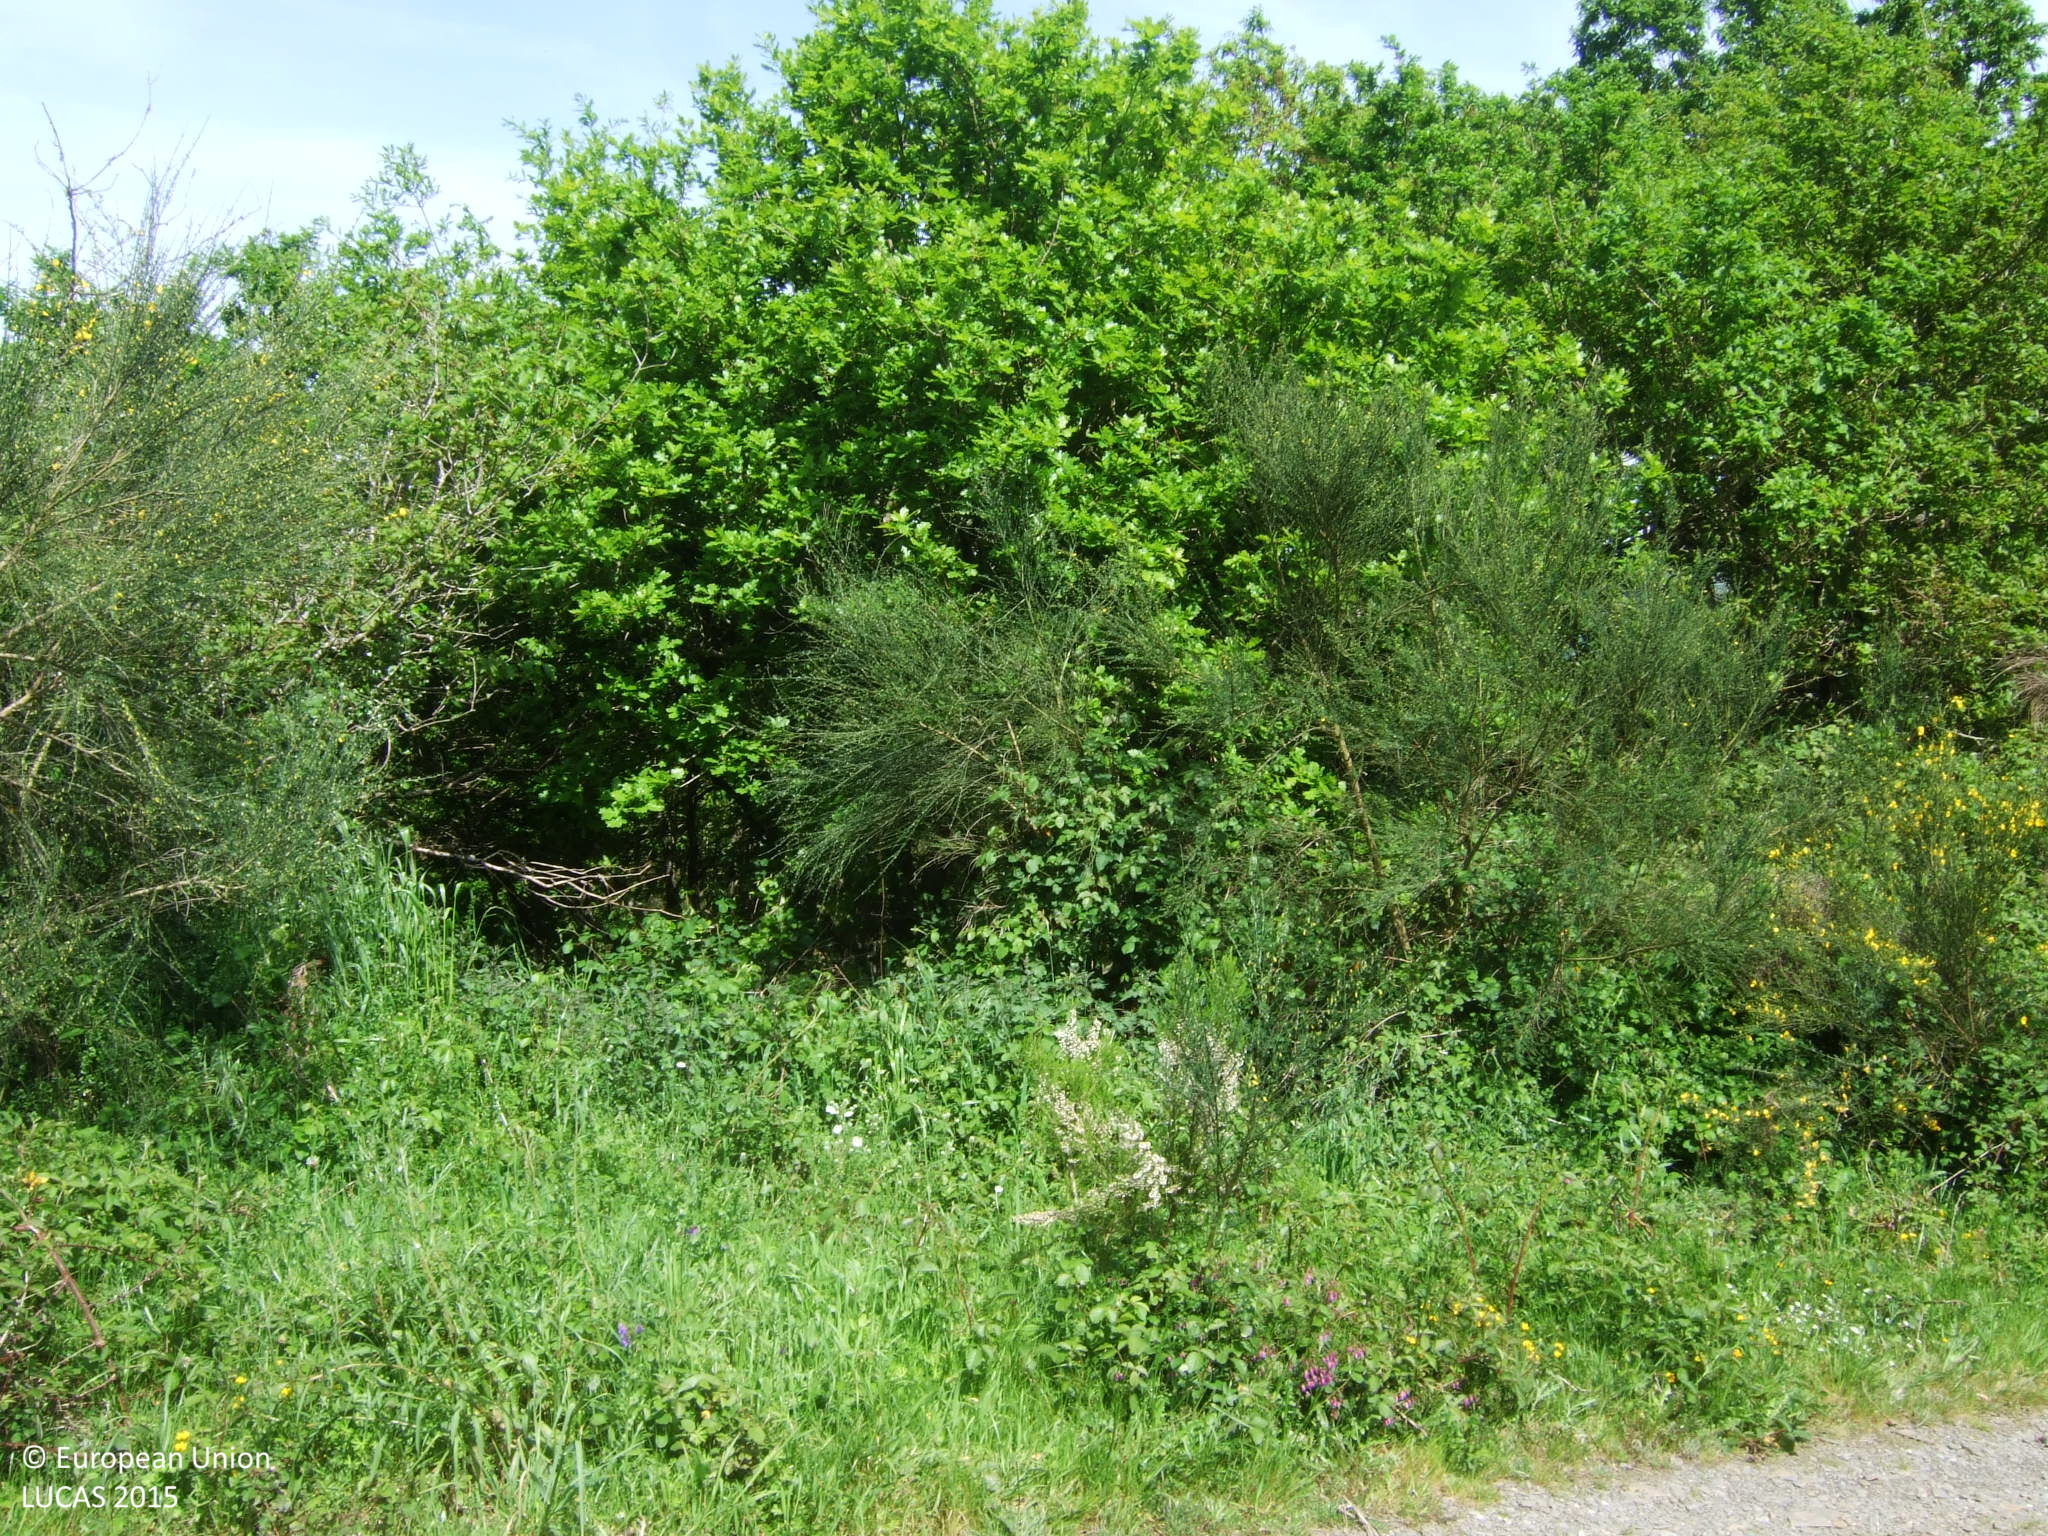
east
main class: Shrubland
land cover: Shrubland without tree cover
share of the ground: > 75 %
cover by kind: shrubs 100 %
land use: Abandoned areas
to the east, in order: Shrubland without tree cover; Tracks; Shruby margins; Broadleaved woodland; Dry stone walls; Broadleaved woodland; Grassland without tree/shrub cover; Groves; Shruby margins; Temporary grasslands
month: May
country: ES
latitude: 43.0948
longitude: -7.3587
